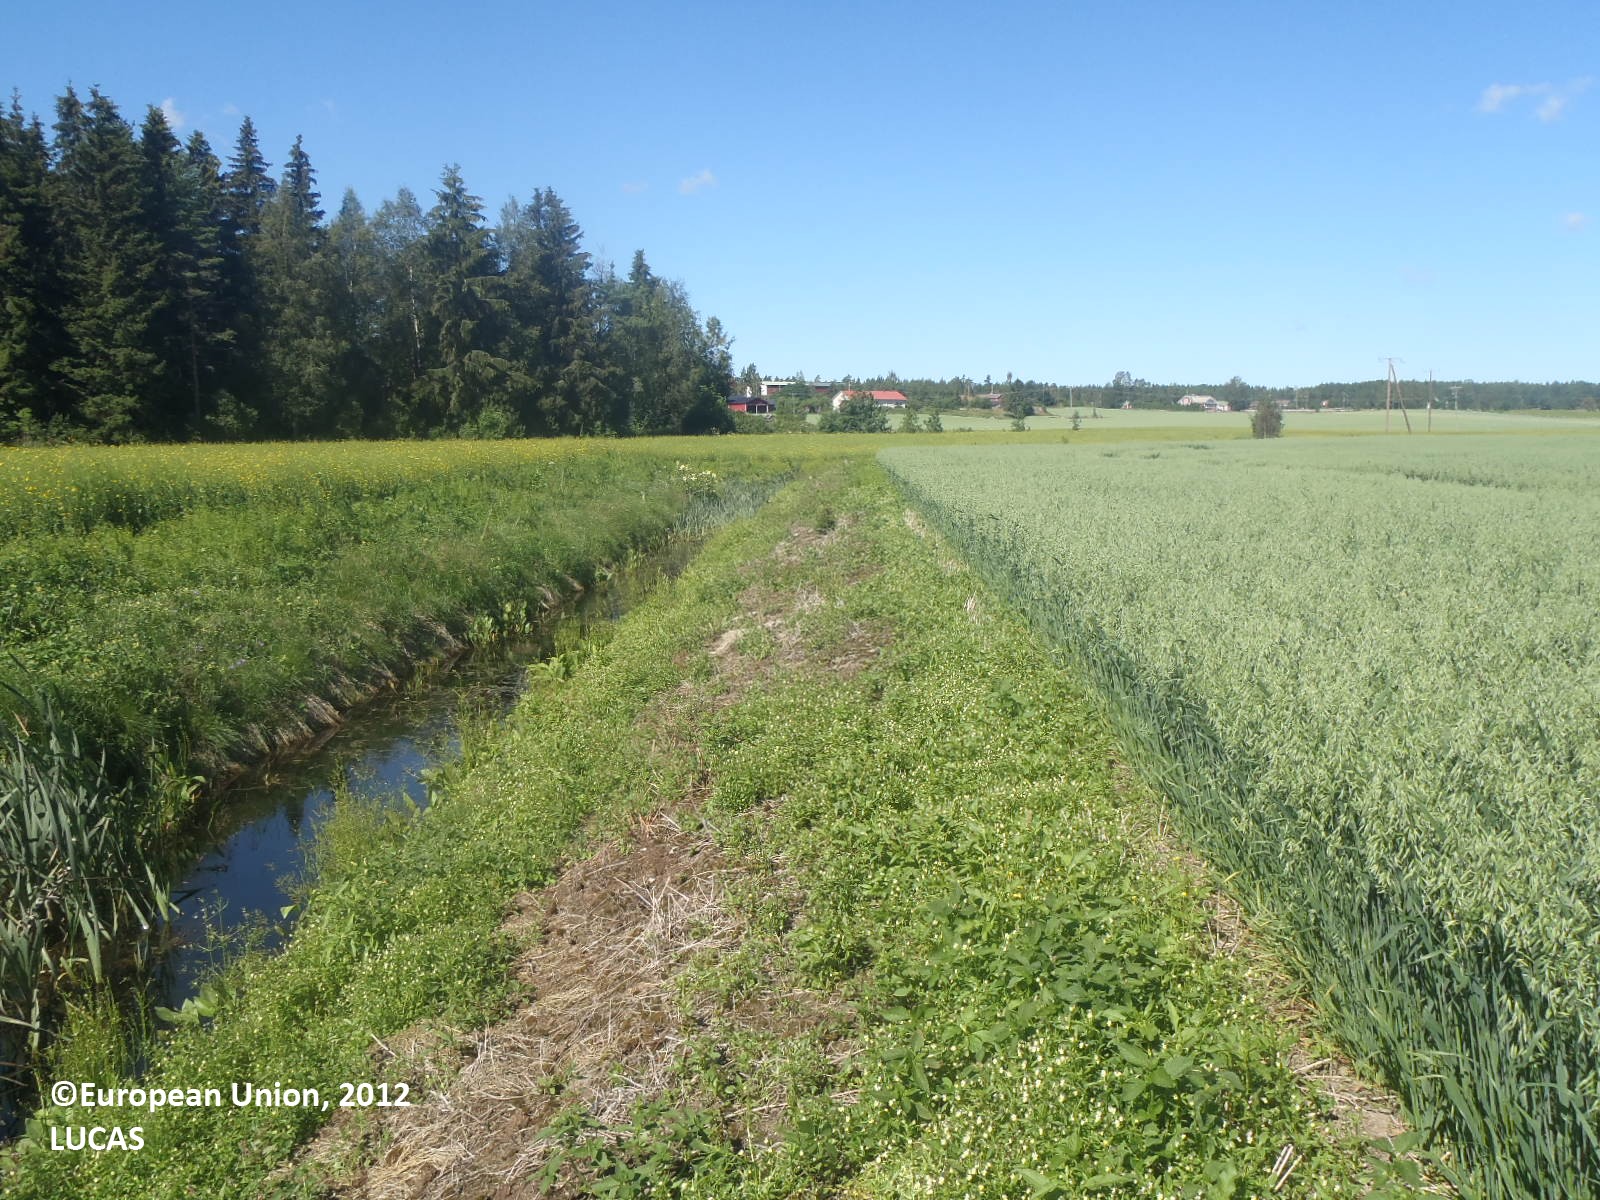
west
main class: Cropland
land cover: Oats
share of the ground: > 75 %
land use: Agriculture (excluding fallow land and kitchen gardens)
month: July
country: FI
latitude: 61.0438
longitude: 21.8902
